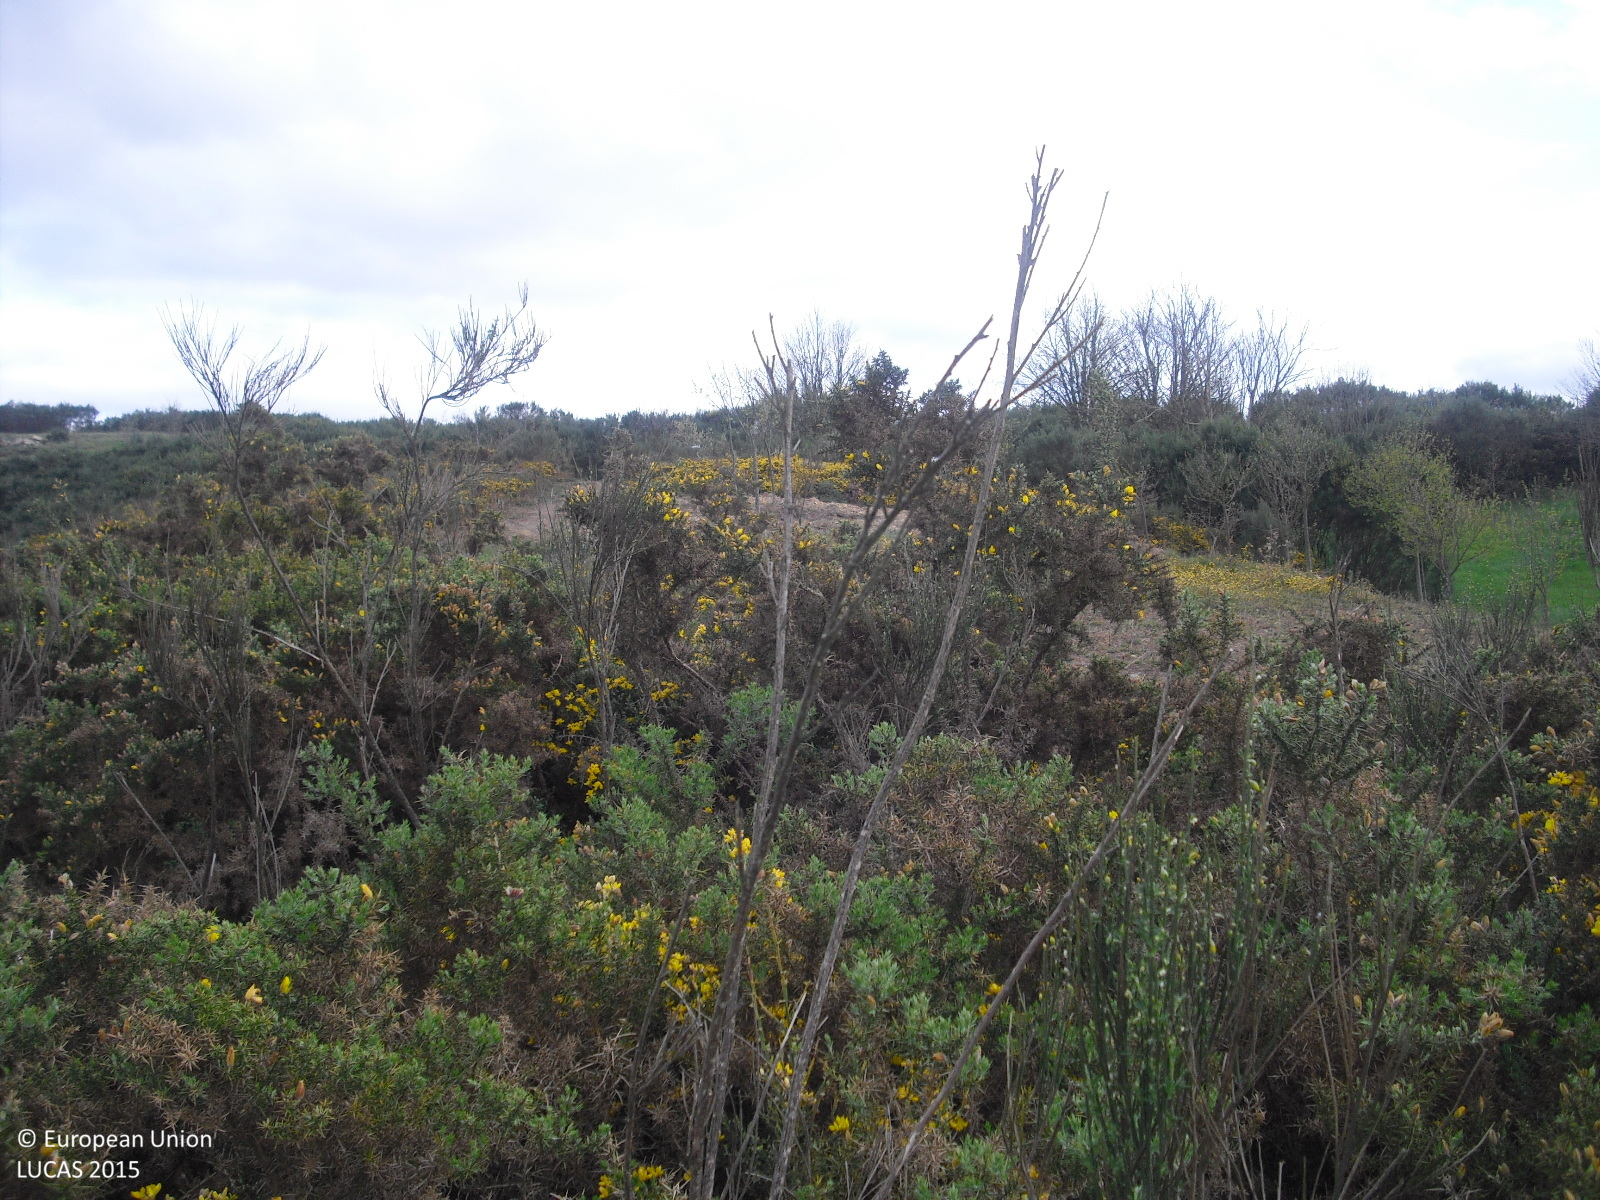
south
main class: Shrubland
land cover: Shrubland without tree cover
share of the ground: > 75 %
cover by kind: shrubs 100 %
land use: Abandoned areas
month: April
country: ES
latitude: 41.8671
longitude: -7.3203
